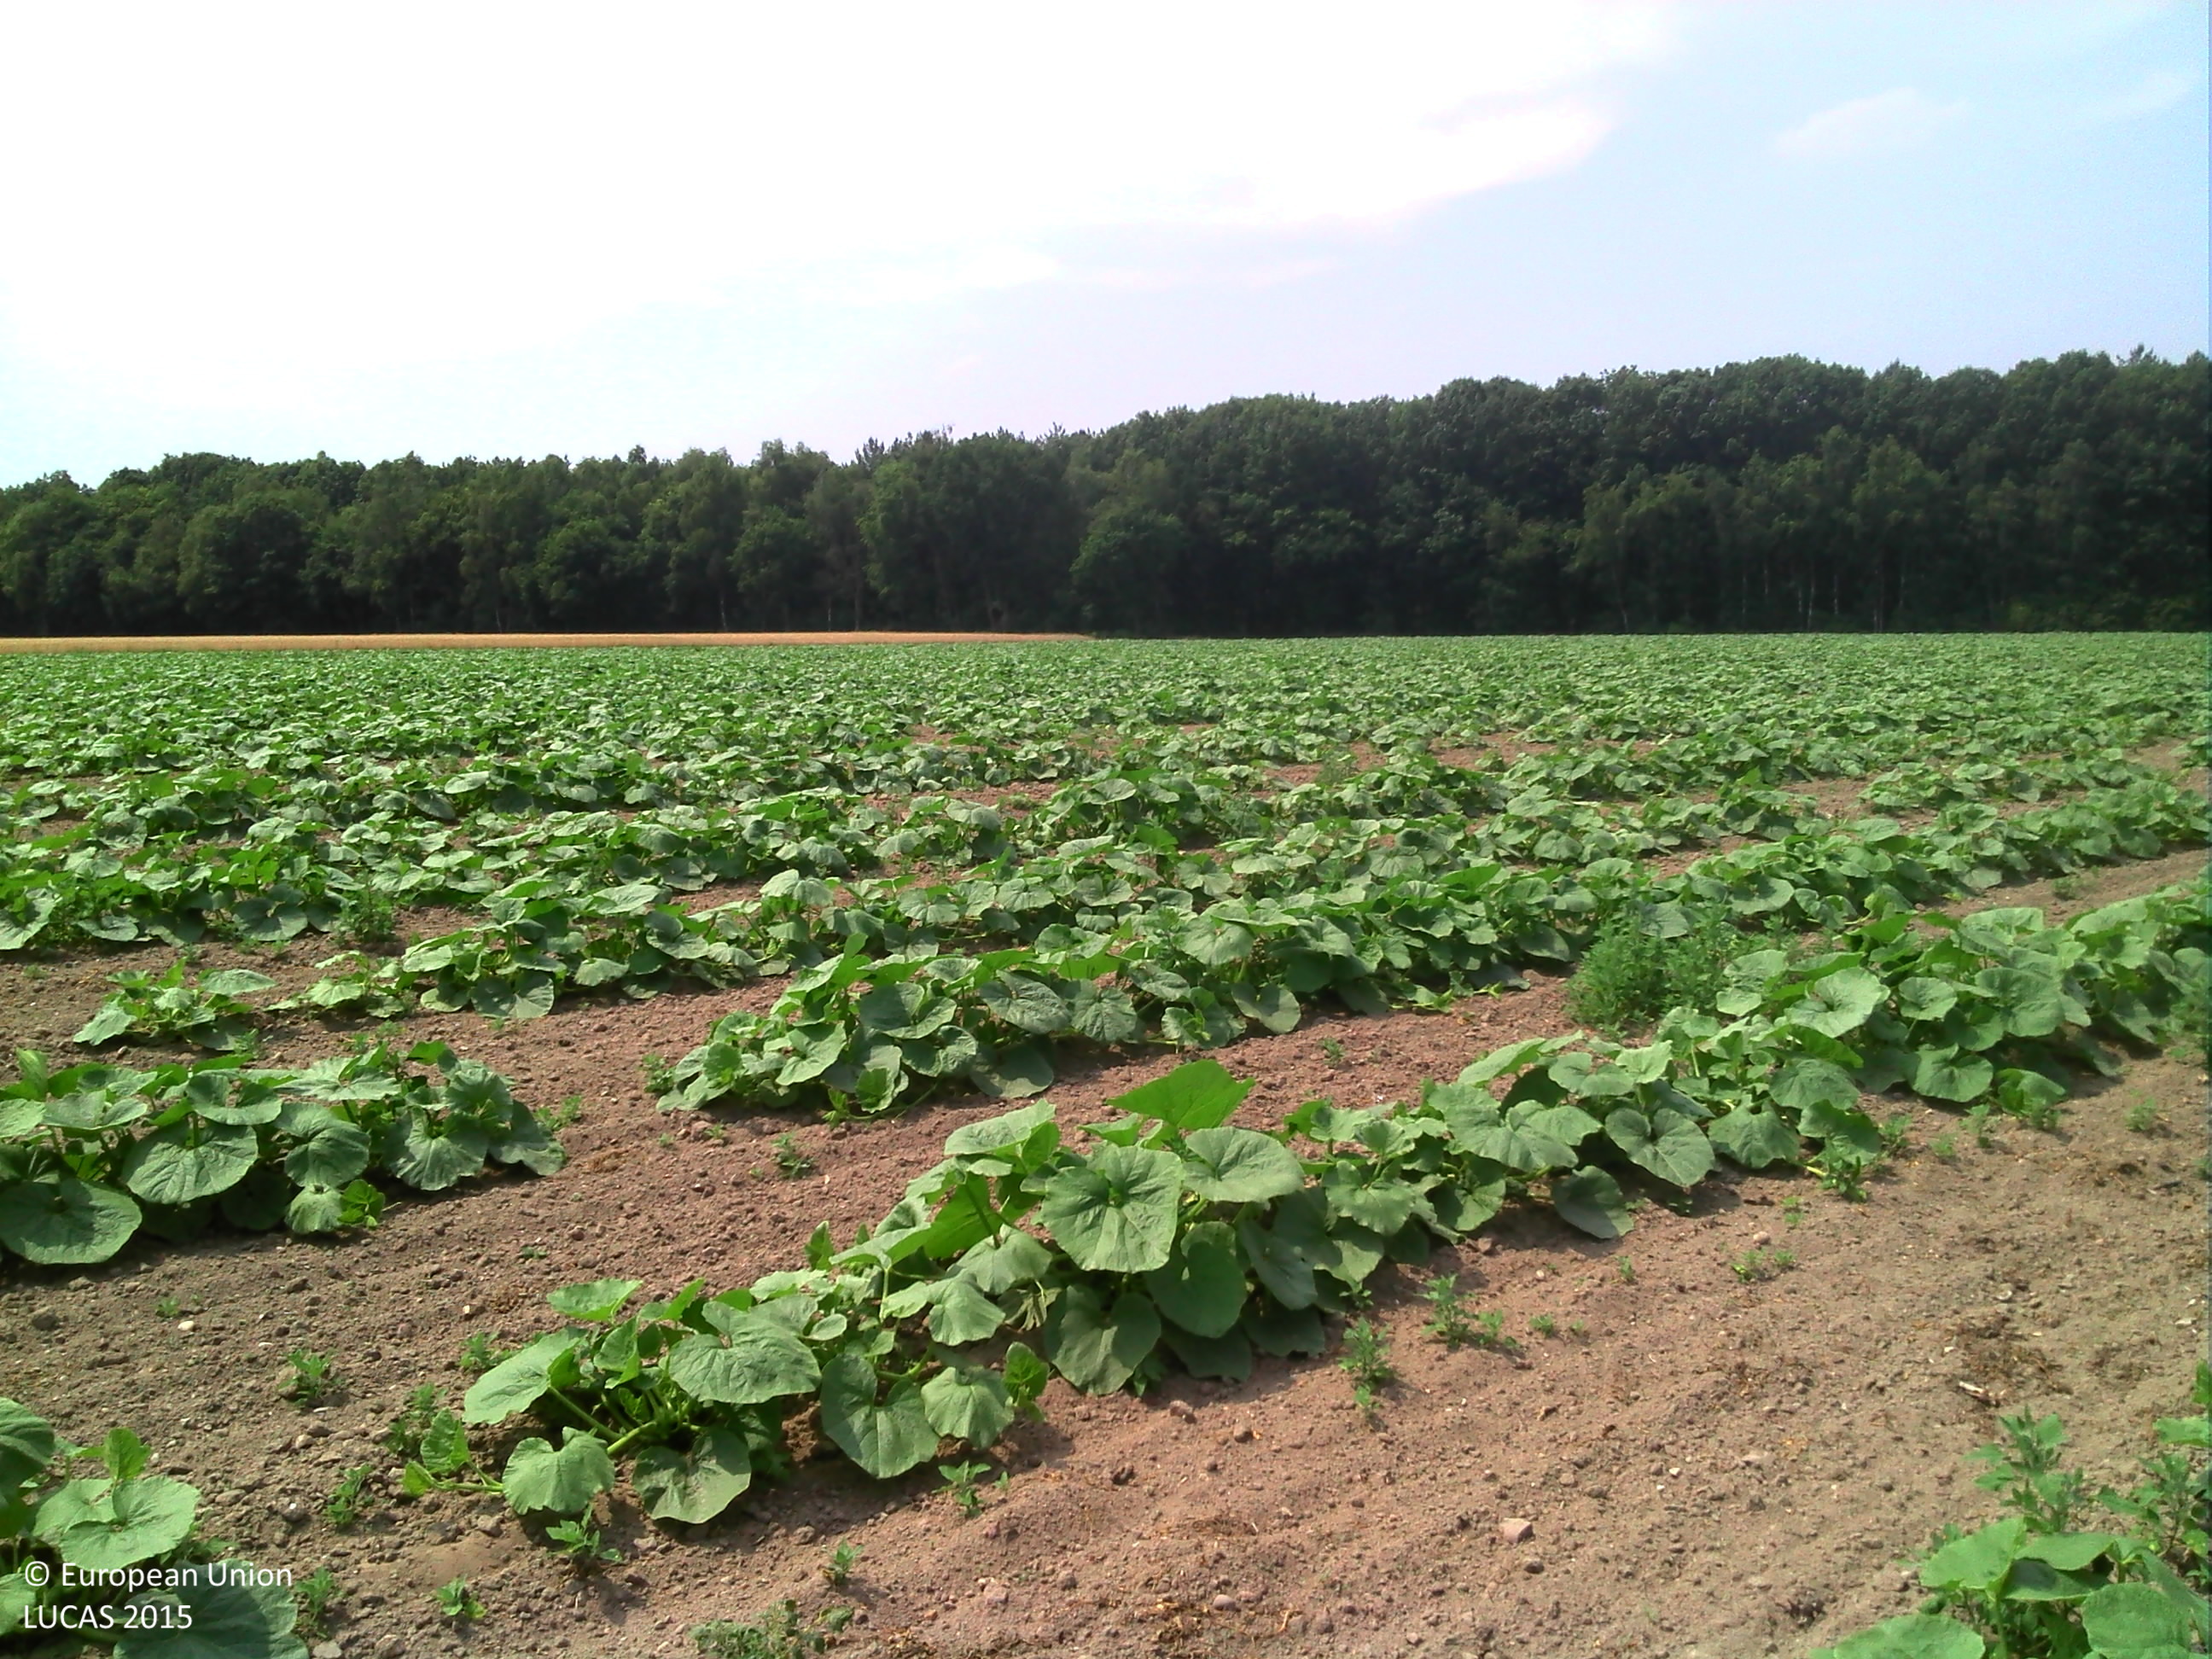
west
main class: Cropland
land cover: Other fresh vegetables
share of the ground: 10 - 25 %
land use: Agriculture (excluding fallow land and kitchen gardens)
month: July
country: BE
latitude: 51.0512
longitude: 5.5331
